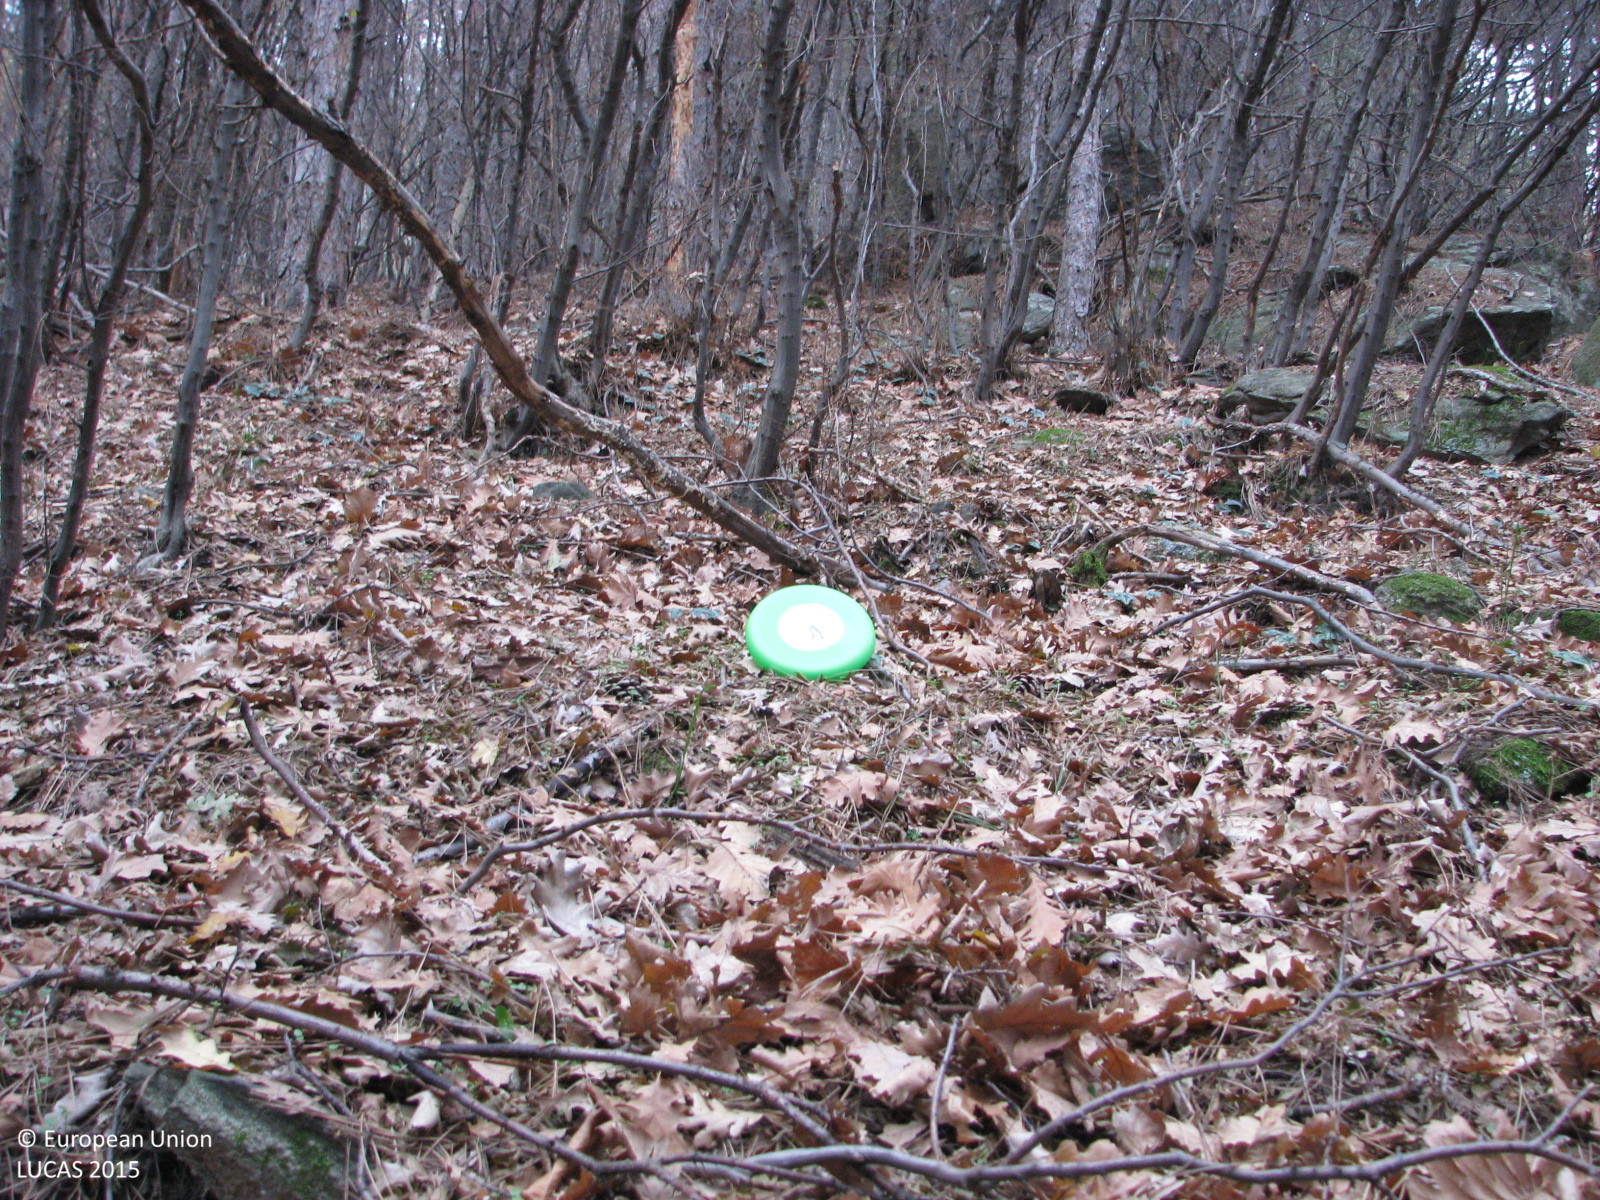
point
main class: Woodland
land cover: Pine dominated mixed woodland
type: hemiboreal forest and nemoral coniferous forest and mixed broadleaved-coniferous forest
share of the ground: > 75 %
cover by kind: coniferous forest trees 60 %, broadleaved forest trees 30 %, unconsolidated bare surface 10 %
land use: Forestry
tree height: > 5 m
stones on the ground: < 10 %
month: December
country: BG
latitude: 42.2949
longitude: 24.0255
